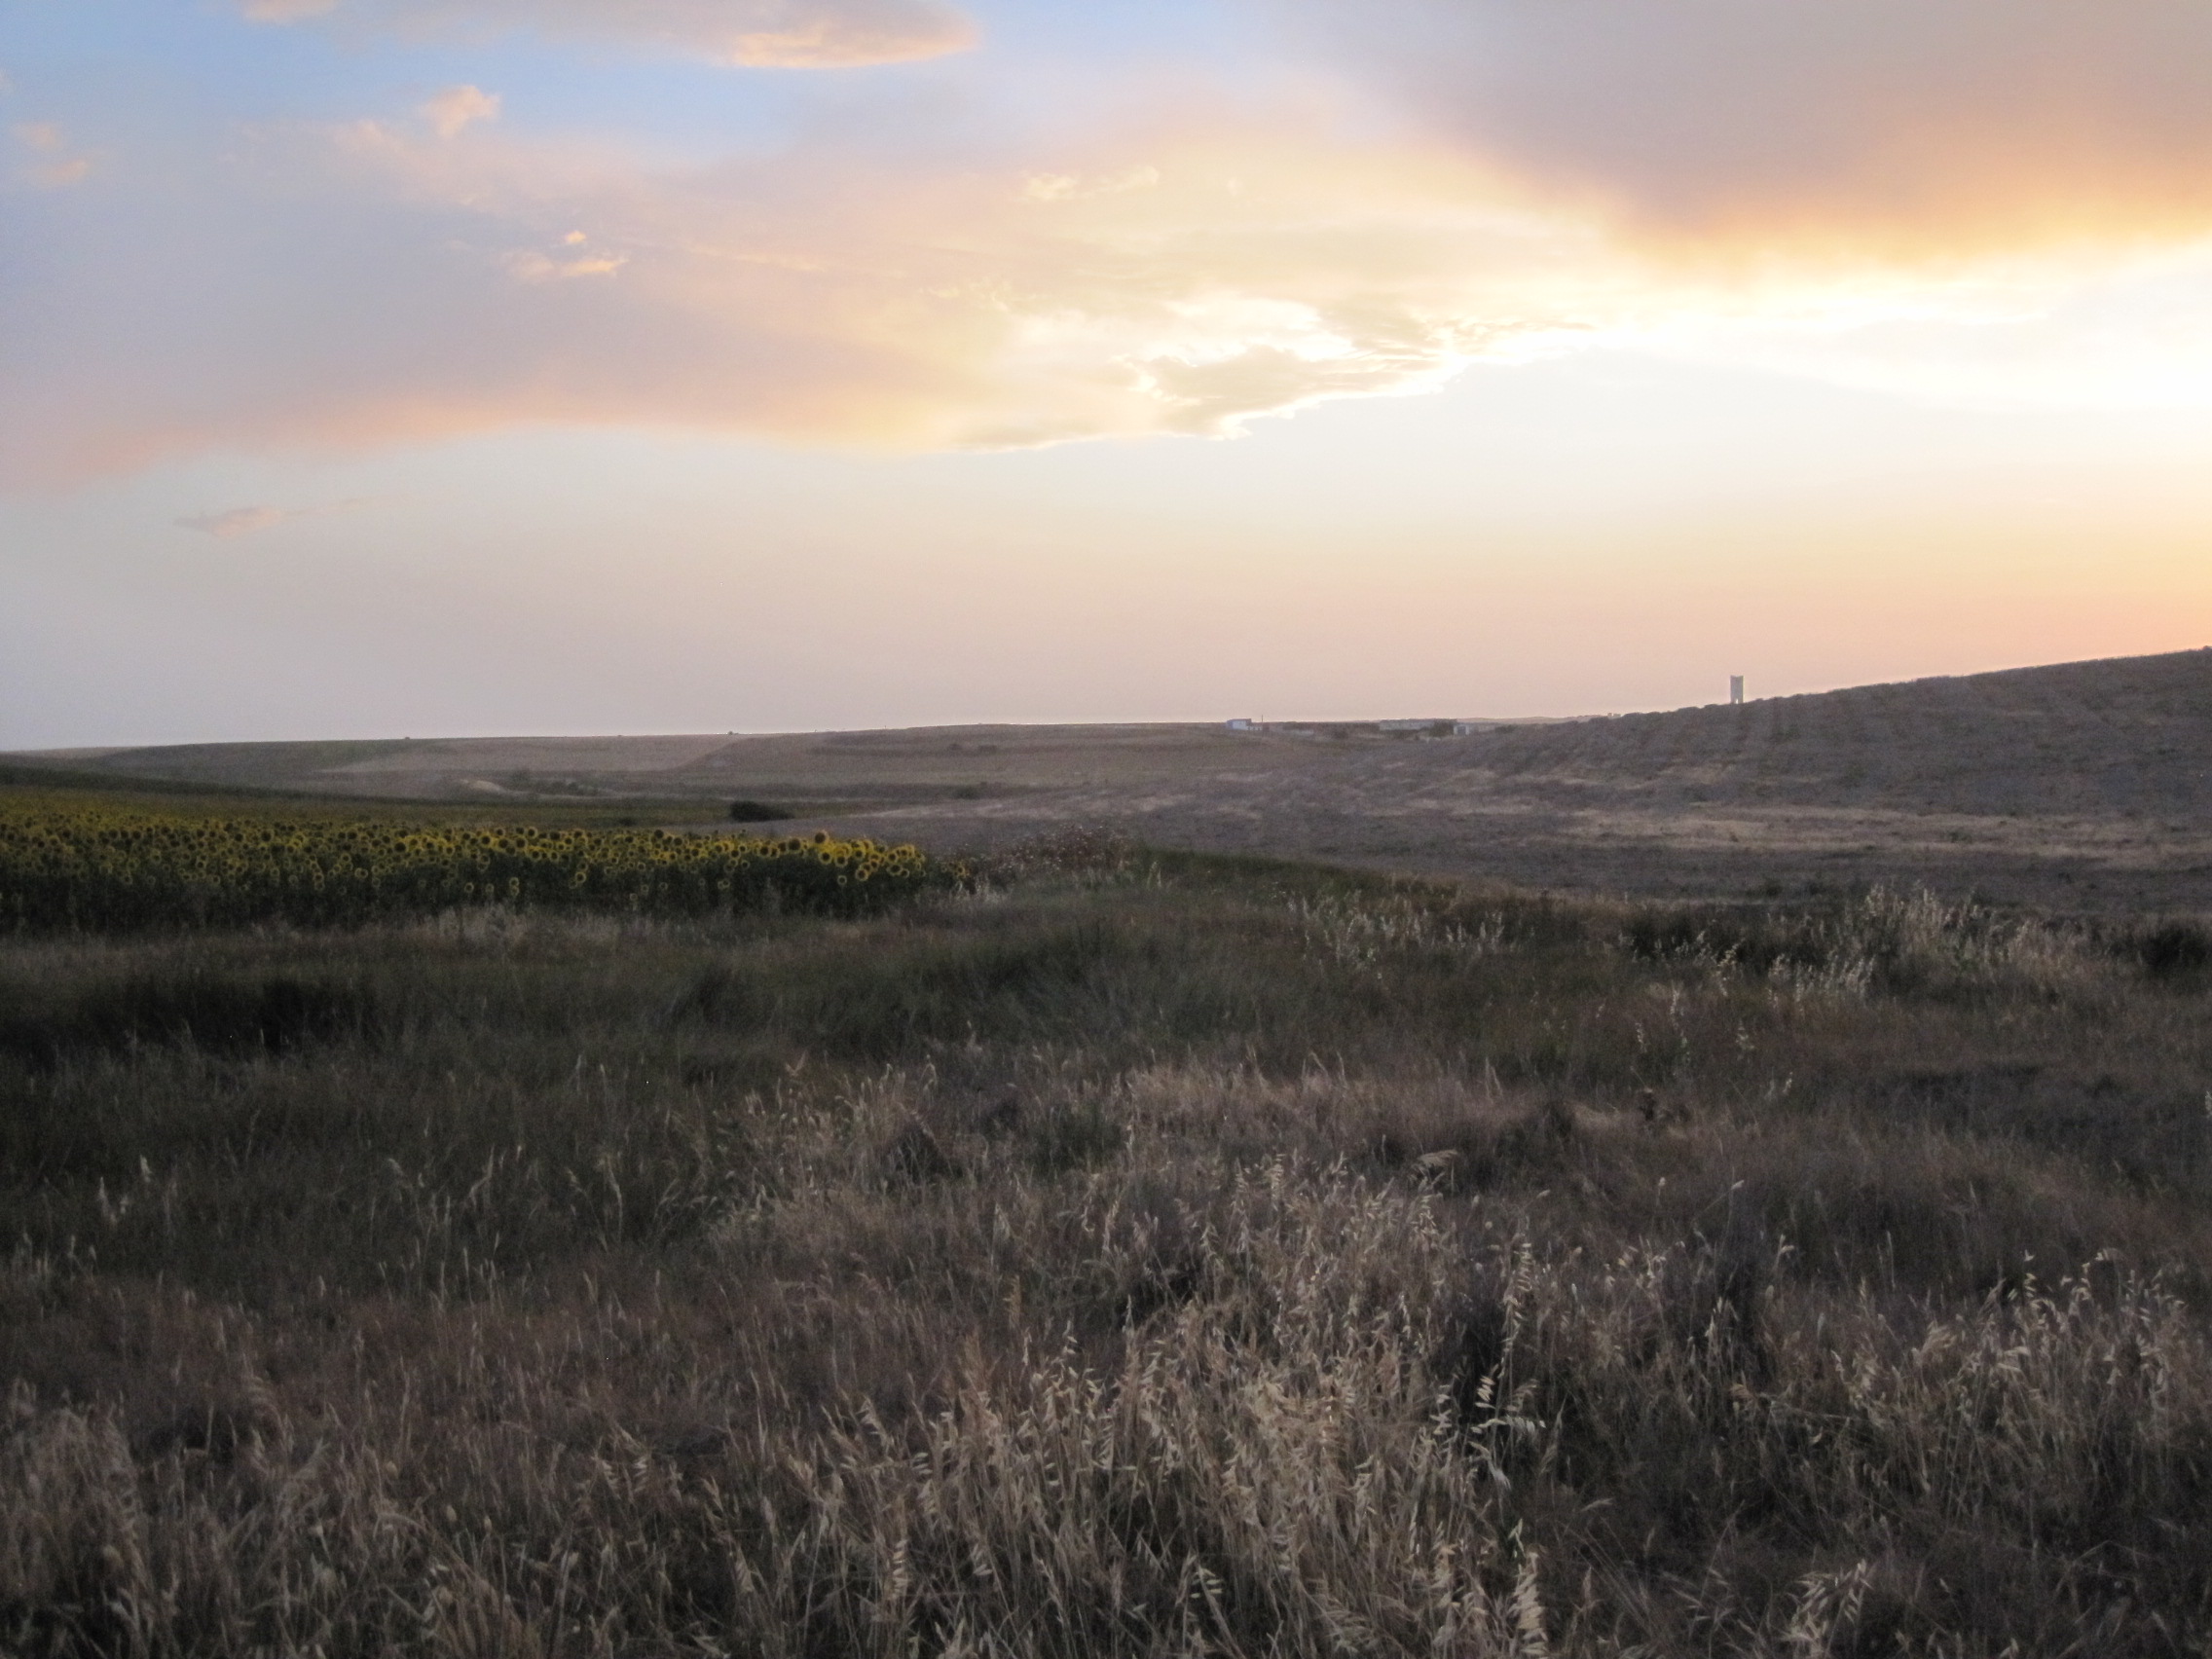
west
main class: Grassland
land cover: Grassland without tree/shrub cover
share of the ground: > 75 %
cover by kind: herbaceous plants 100 %
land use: Abandoned areas
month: July
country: ES
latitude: 41.7655
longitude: -5.4937
